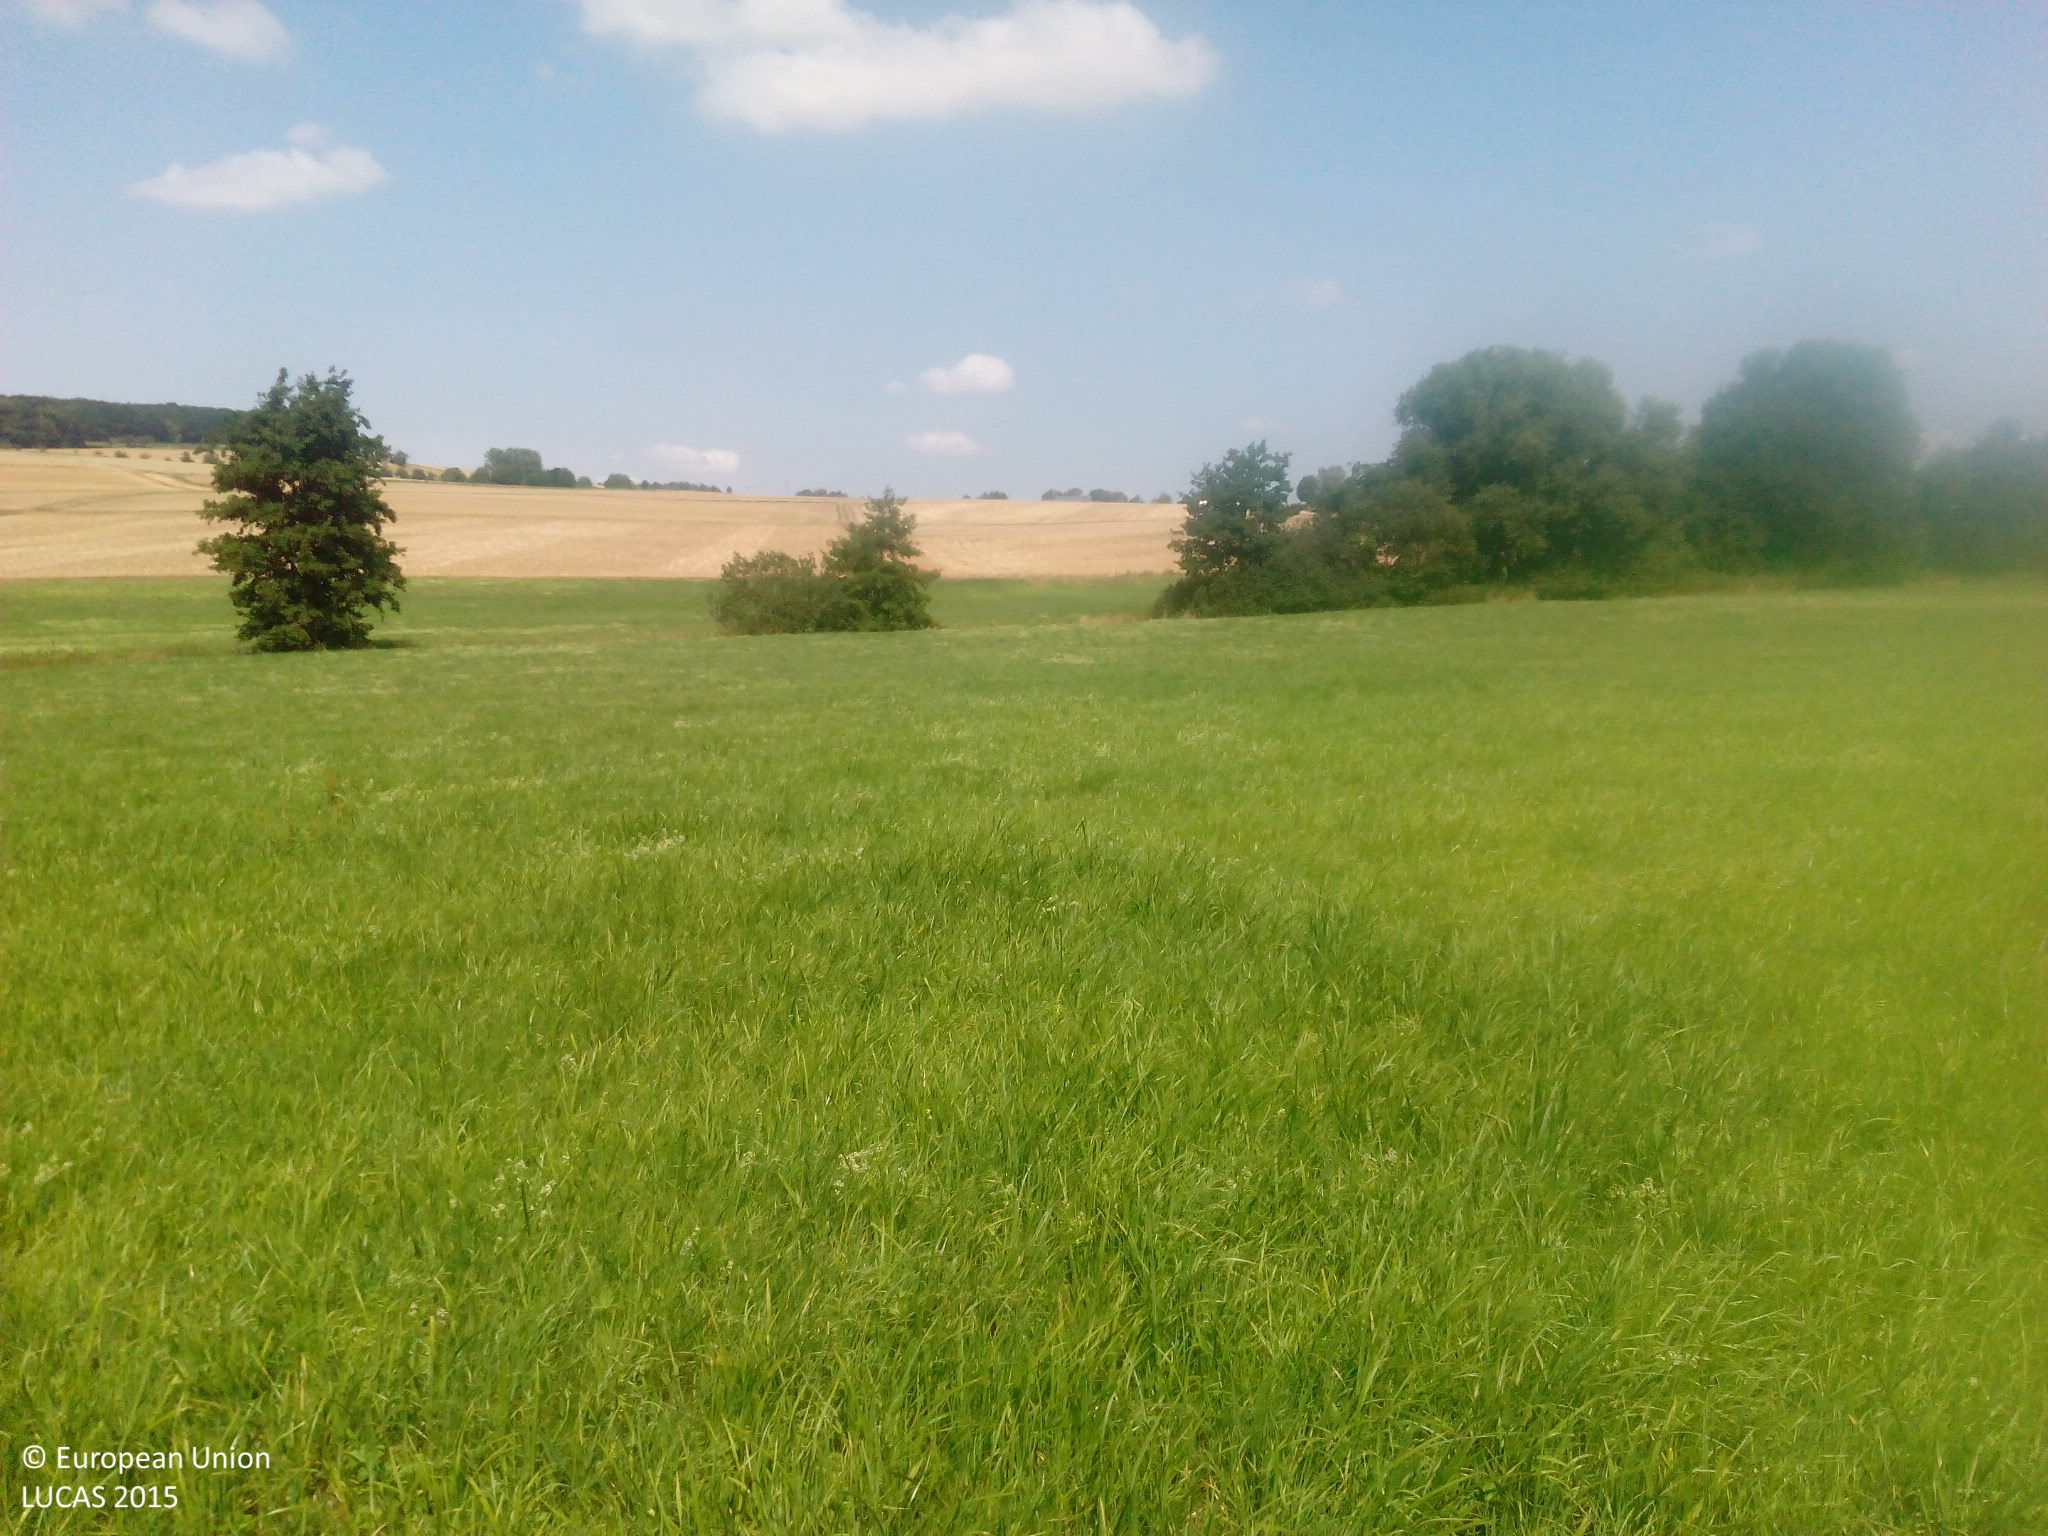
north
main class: Grassland
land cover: Grassland without tree/shrub cover
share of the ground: > 75 %
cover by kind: herbaceous plants 95 %, unconsolidated bare surface 5 %
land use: Agriculture (excluding fallow land and kitchen gardens)
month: August
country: DE
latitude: 50.3304
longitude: 8.1039
